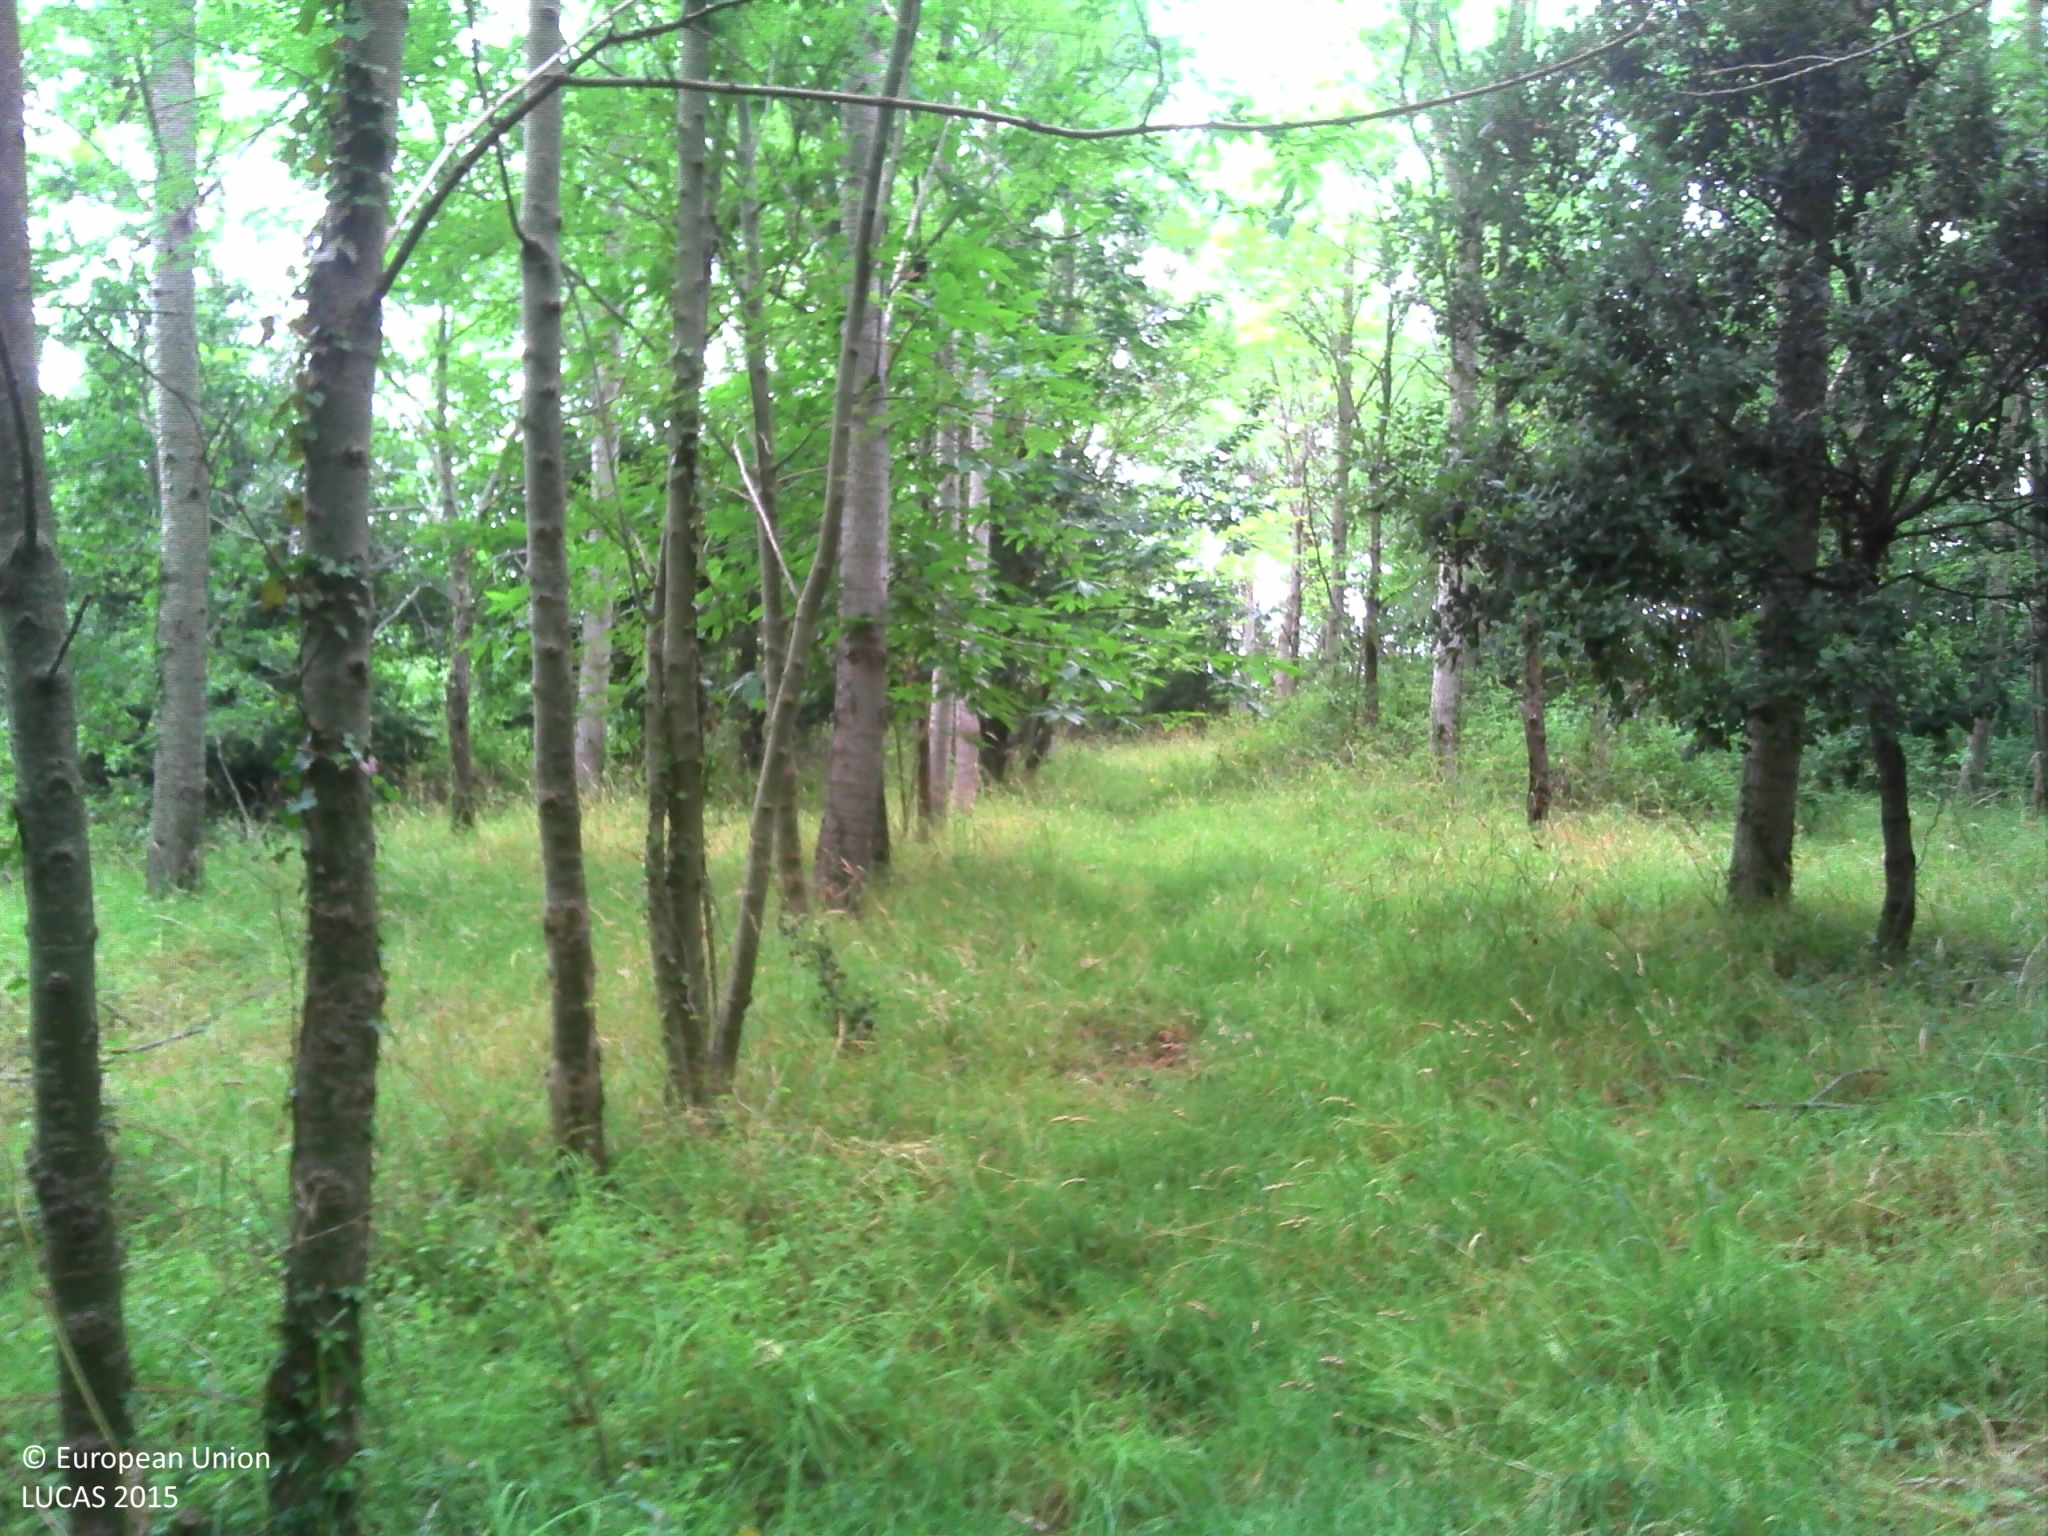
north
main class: Woodland
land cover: Broadleaved woodland
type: mesophytic deciduous forest
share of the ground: > 75 %
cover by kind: broadleaved forest trees 80 %, herbaceous plants 20 %
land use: Forestry
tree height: > 5 m
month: July
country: FR
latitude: 46.7672
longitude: -1.8152
